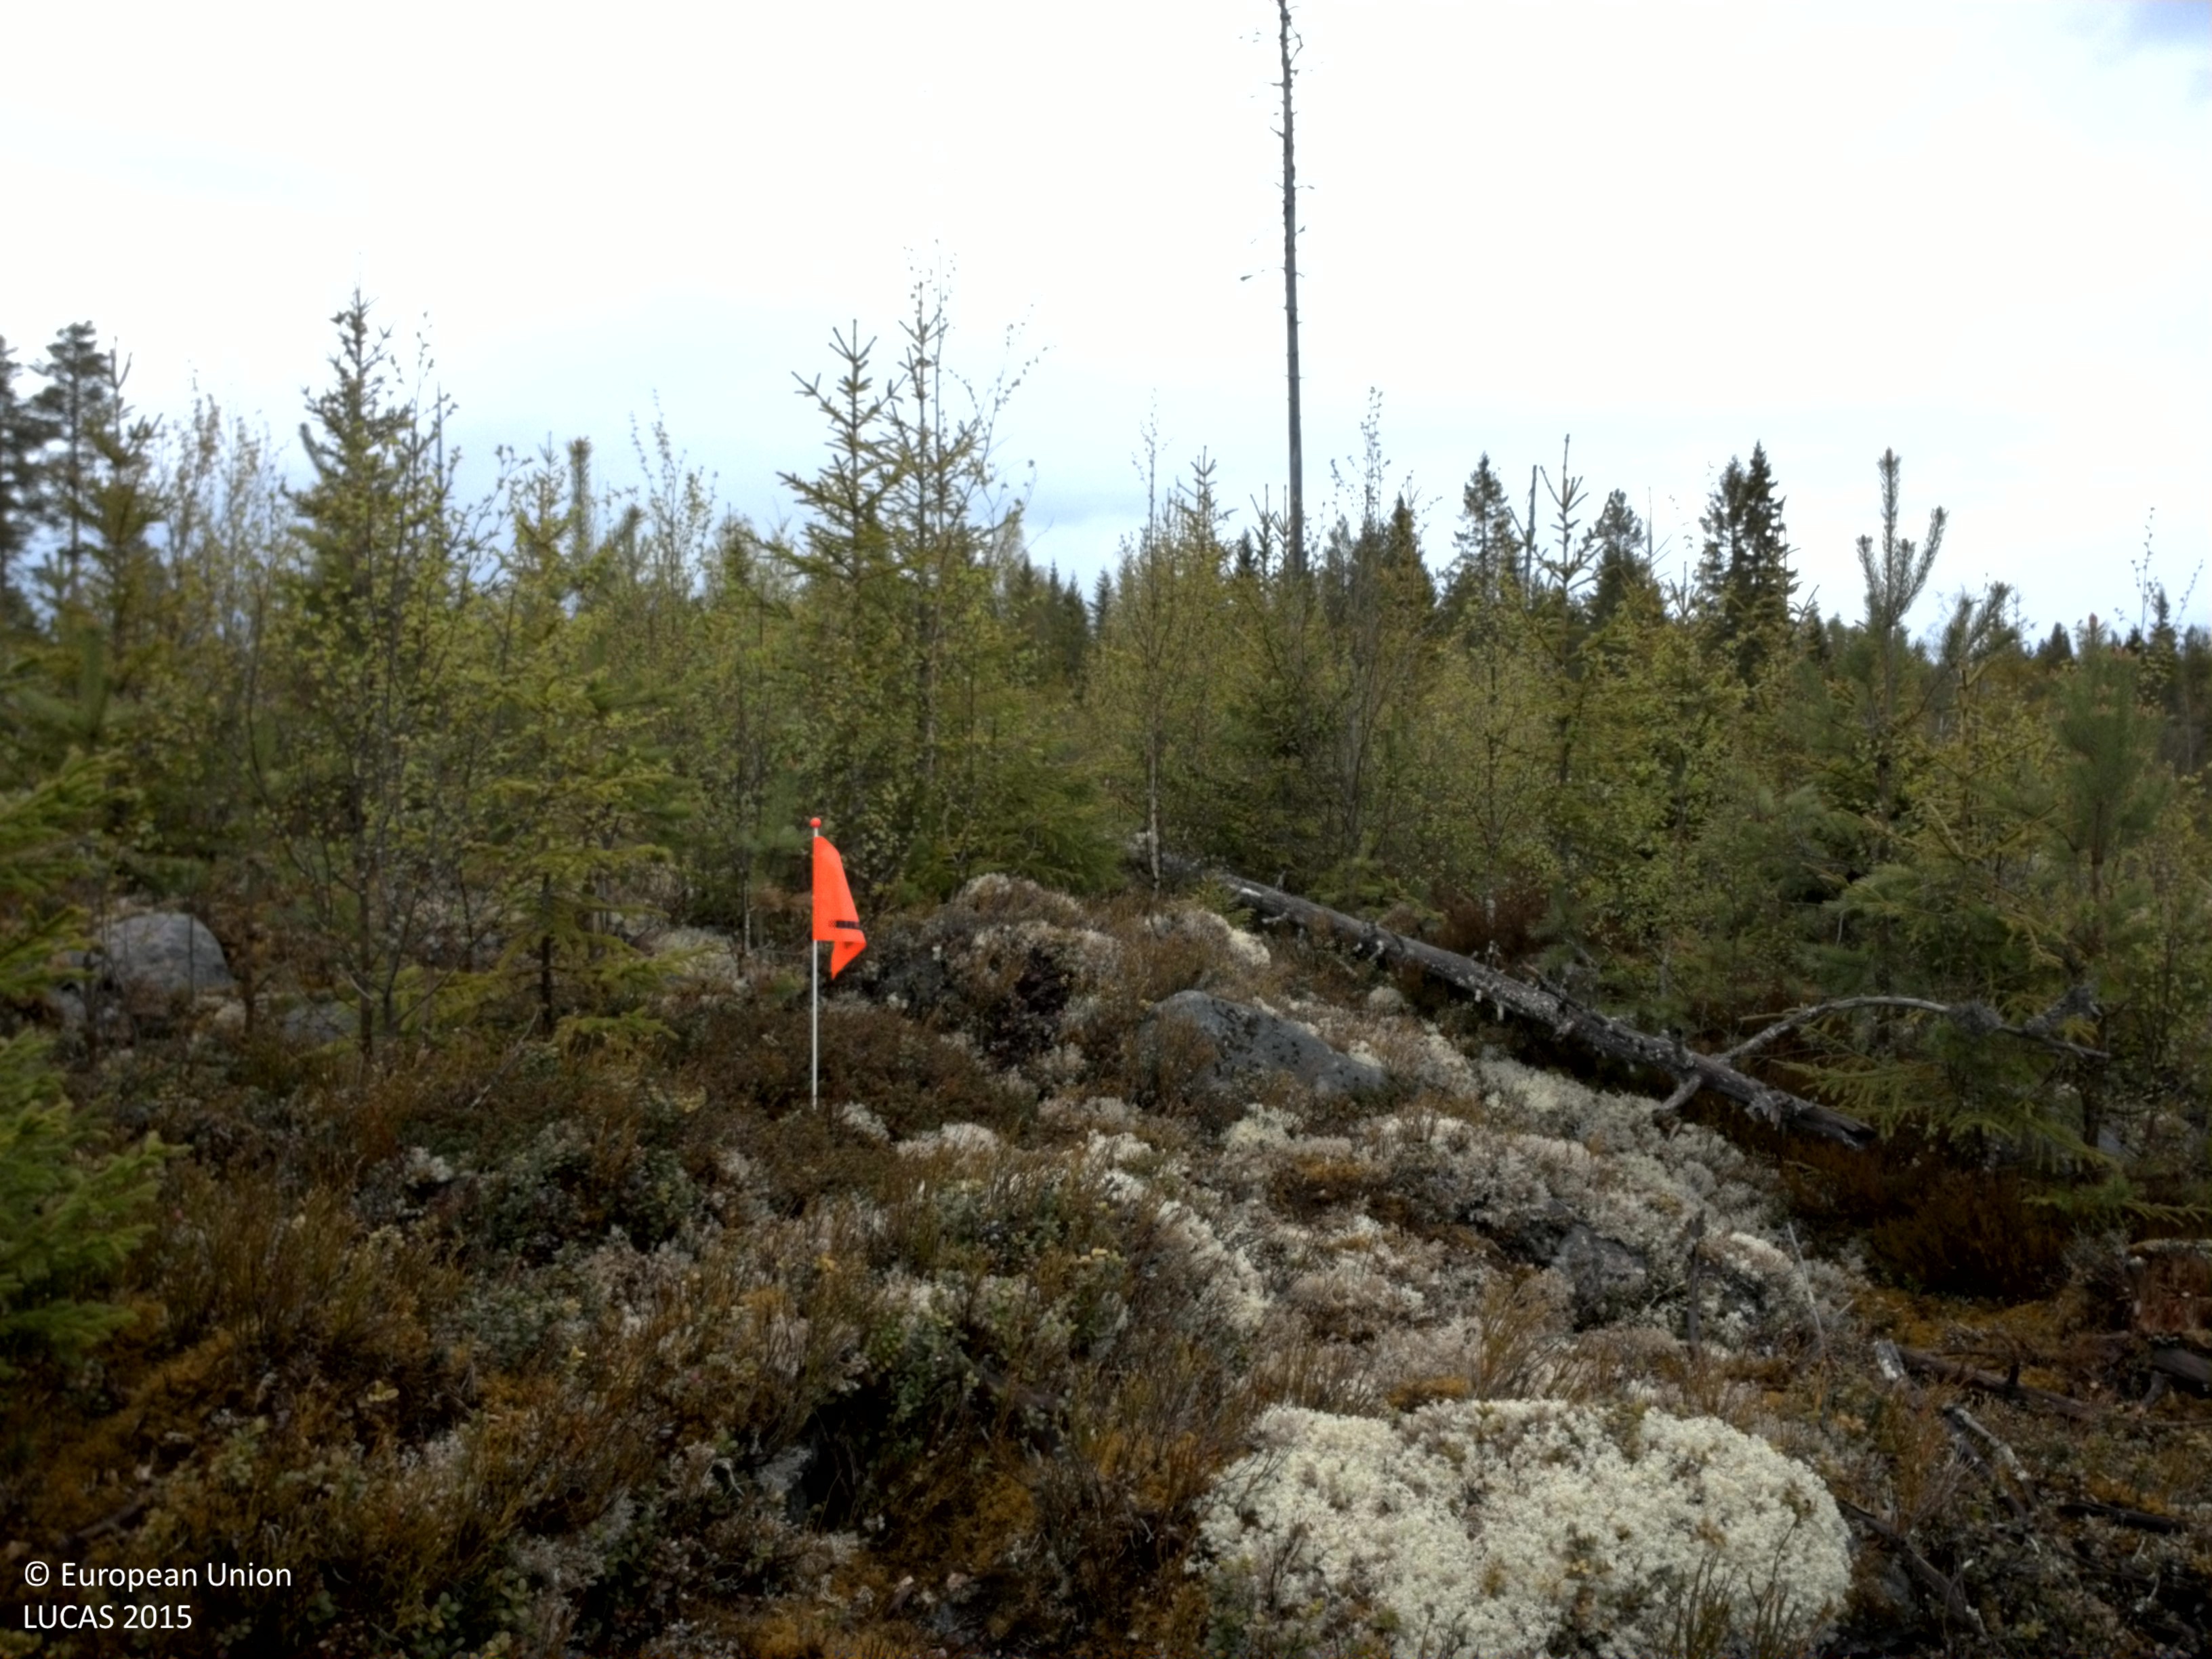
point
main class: Woodland
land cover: Spruce dominated mixed woodland
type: boreal forest
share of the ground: > 75 %
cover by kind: coniferous forest trees 60 %, broadleaved forest trees 25 %, herbaceous plants 10 %, lichens and mosses 5 %
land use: Forestry
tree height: < 5 m
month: May
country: SE
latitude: 61.1096
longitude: 15.3108
